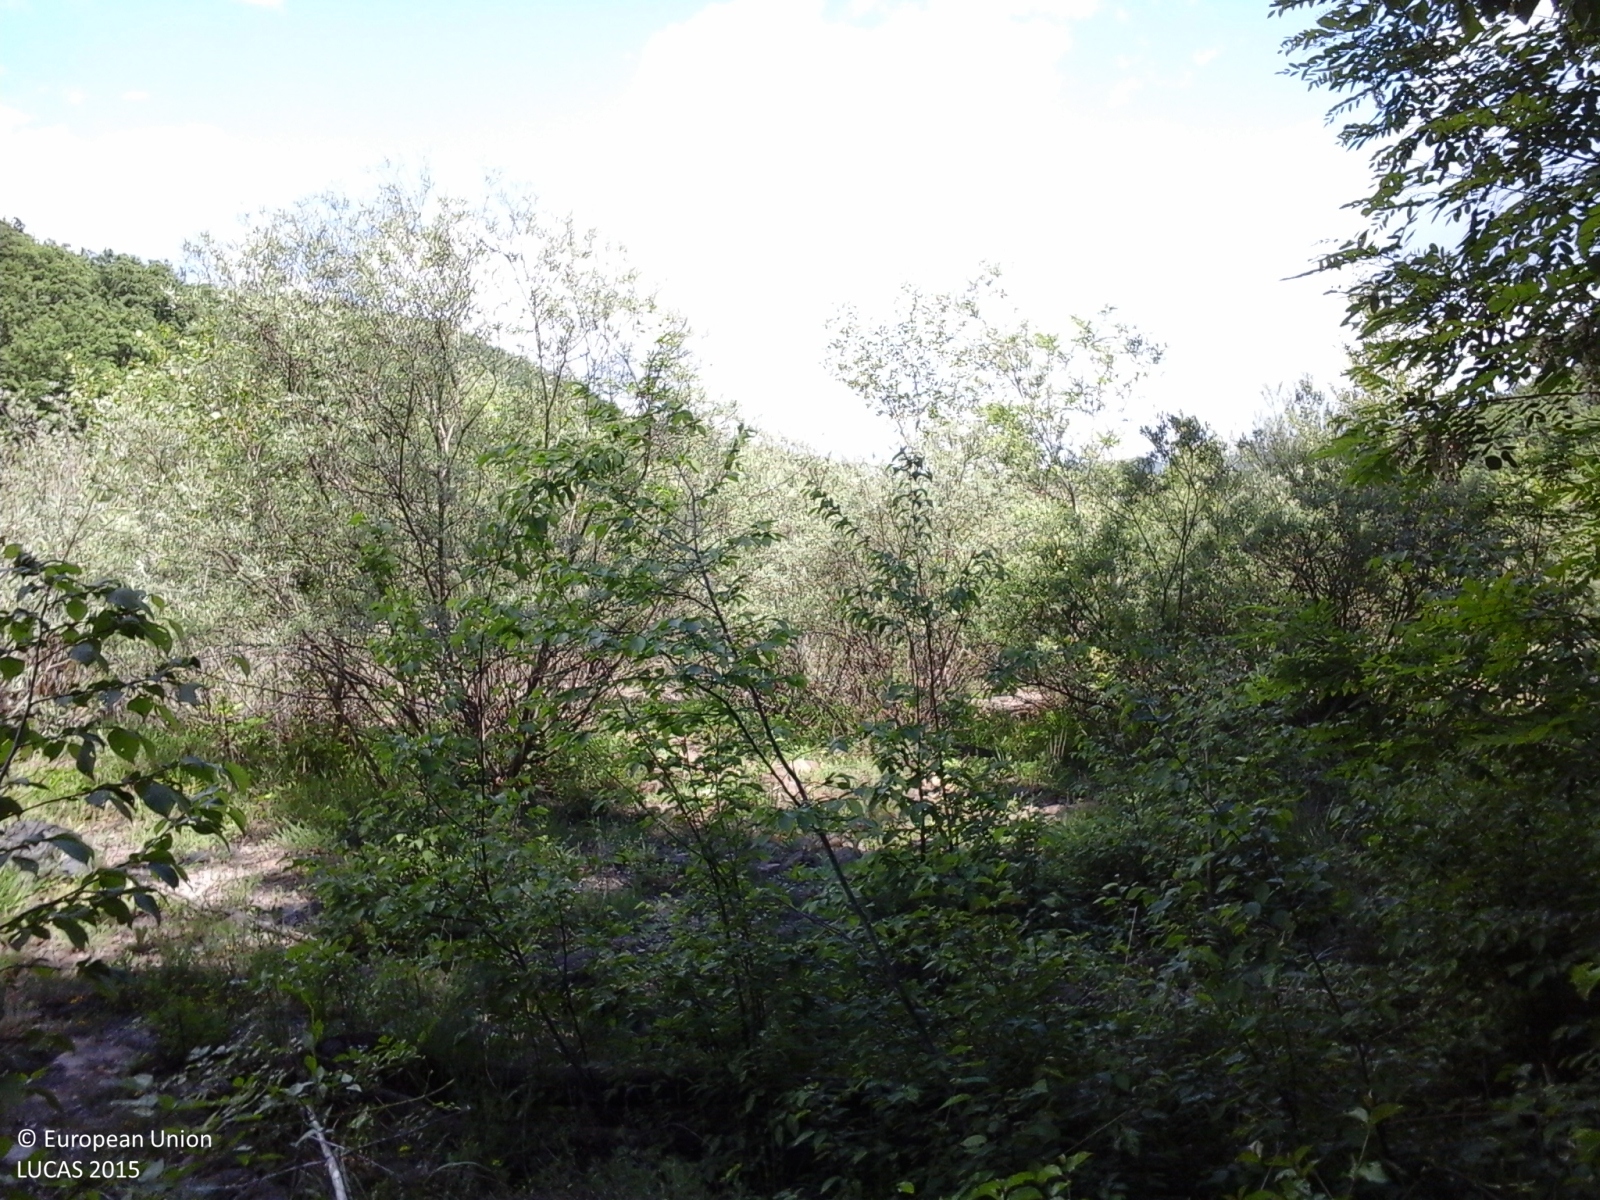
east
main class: Woodland
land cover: Broadleaved woodland
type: thermophilous deciduous forest
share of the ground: > 75 %
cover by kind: broadleaved forest trees 80 %, shrubs 20 %
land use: Forestry
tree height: > 5 m
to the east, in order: Broadleaved woodland; Inland fresh running water; Shrubland with sparse tree cover; Inland fresh running water
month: May
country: IT
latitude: 44.5850
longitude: 9.9120
